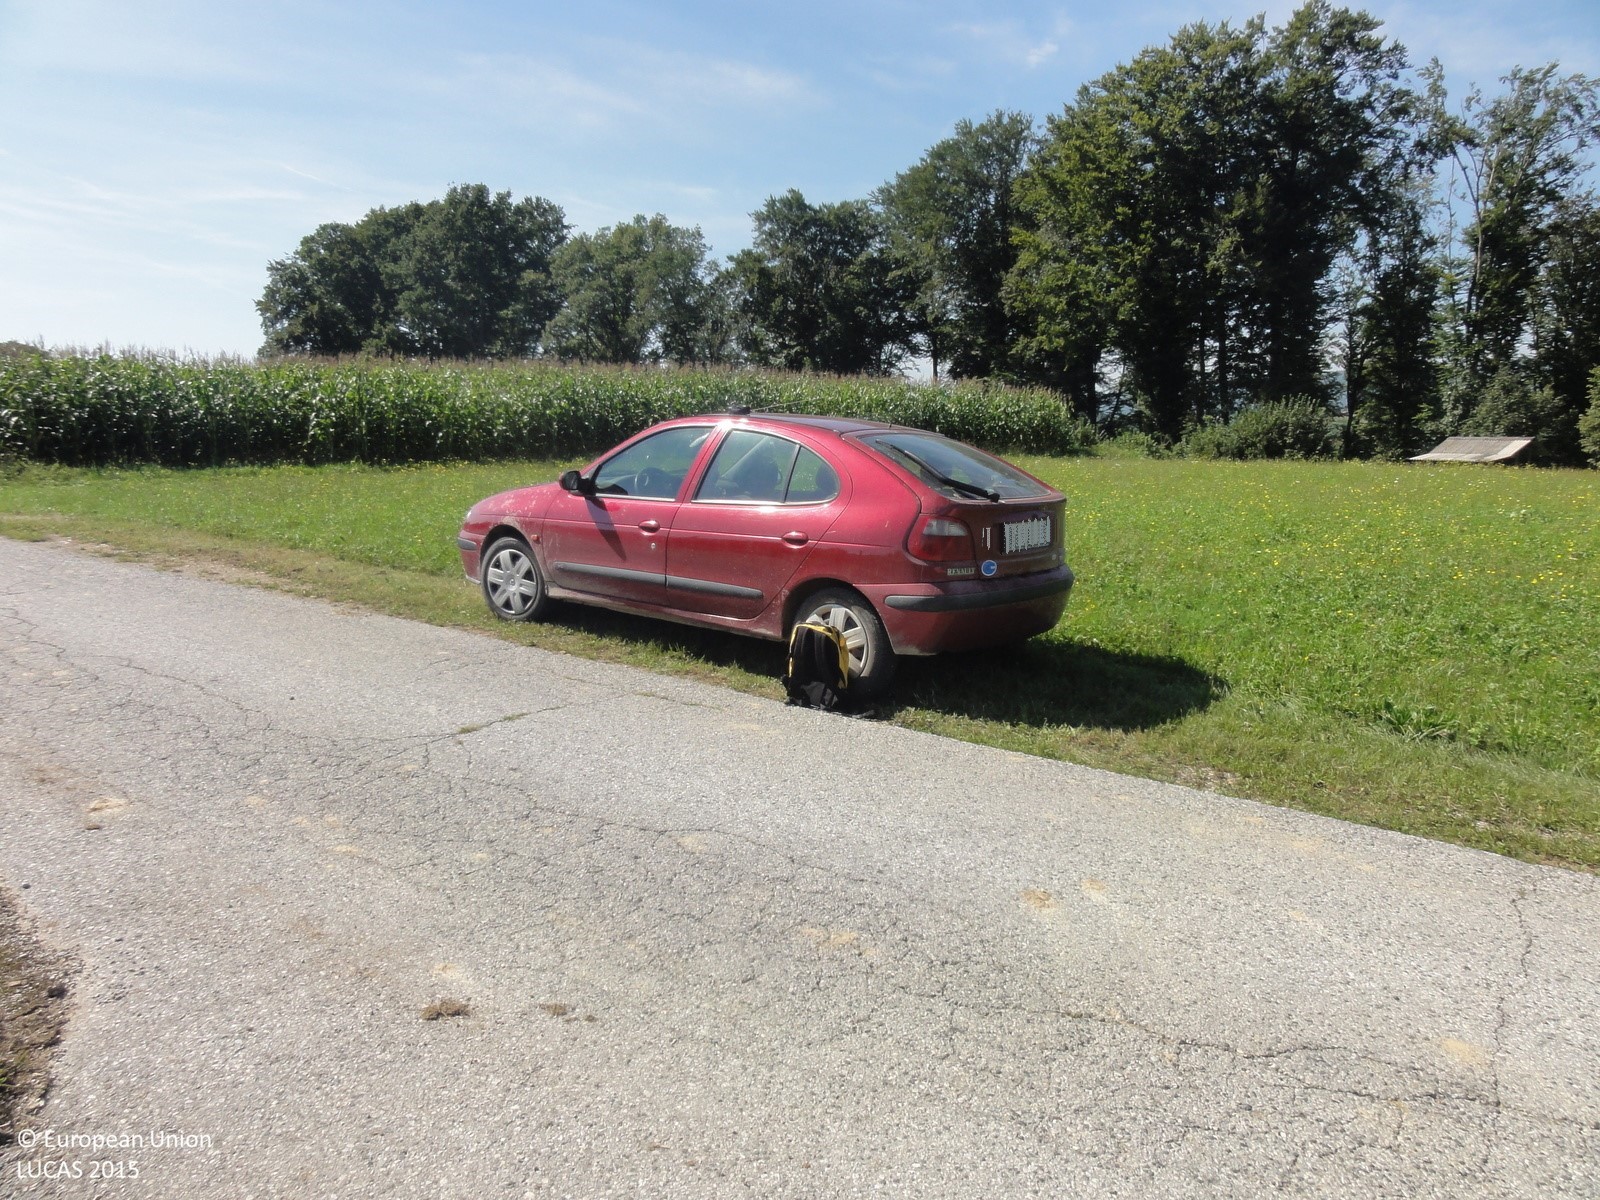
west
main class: Cropland
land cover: Apple fruit
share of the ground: 50 - 75 %
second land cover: Grassland without tree/shrub cover
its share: > 75 %
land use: Agriculture (excluding fallow land and kitchen gardens)
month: August
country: SI
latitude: 45.9952
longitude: 15.4589
